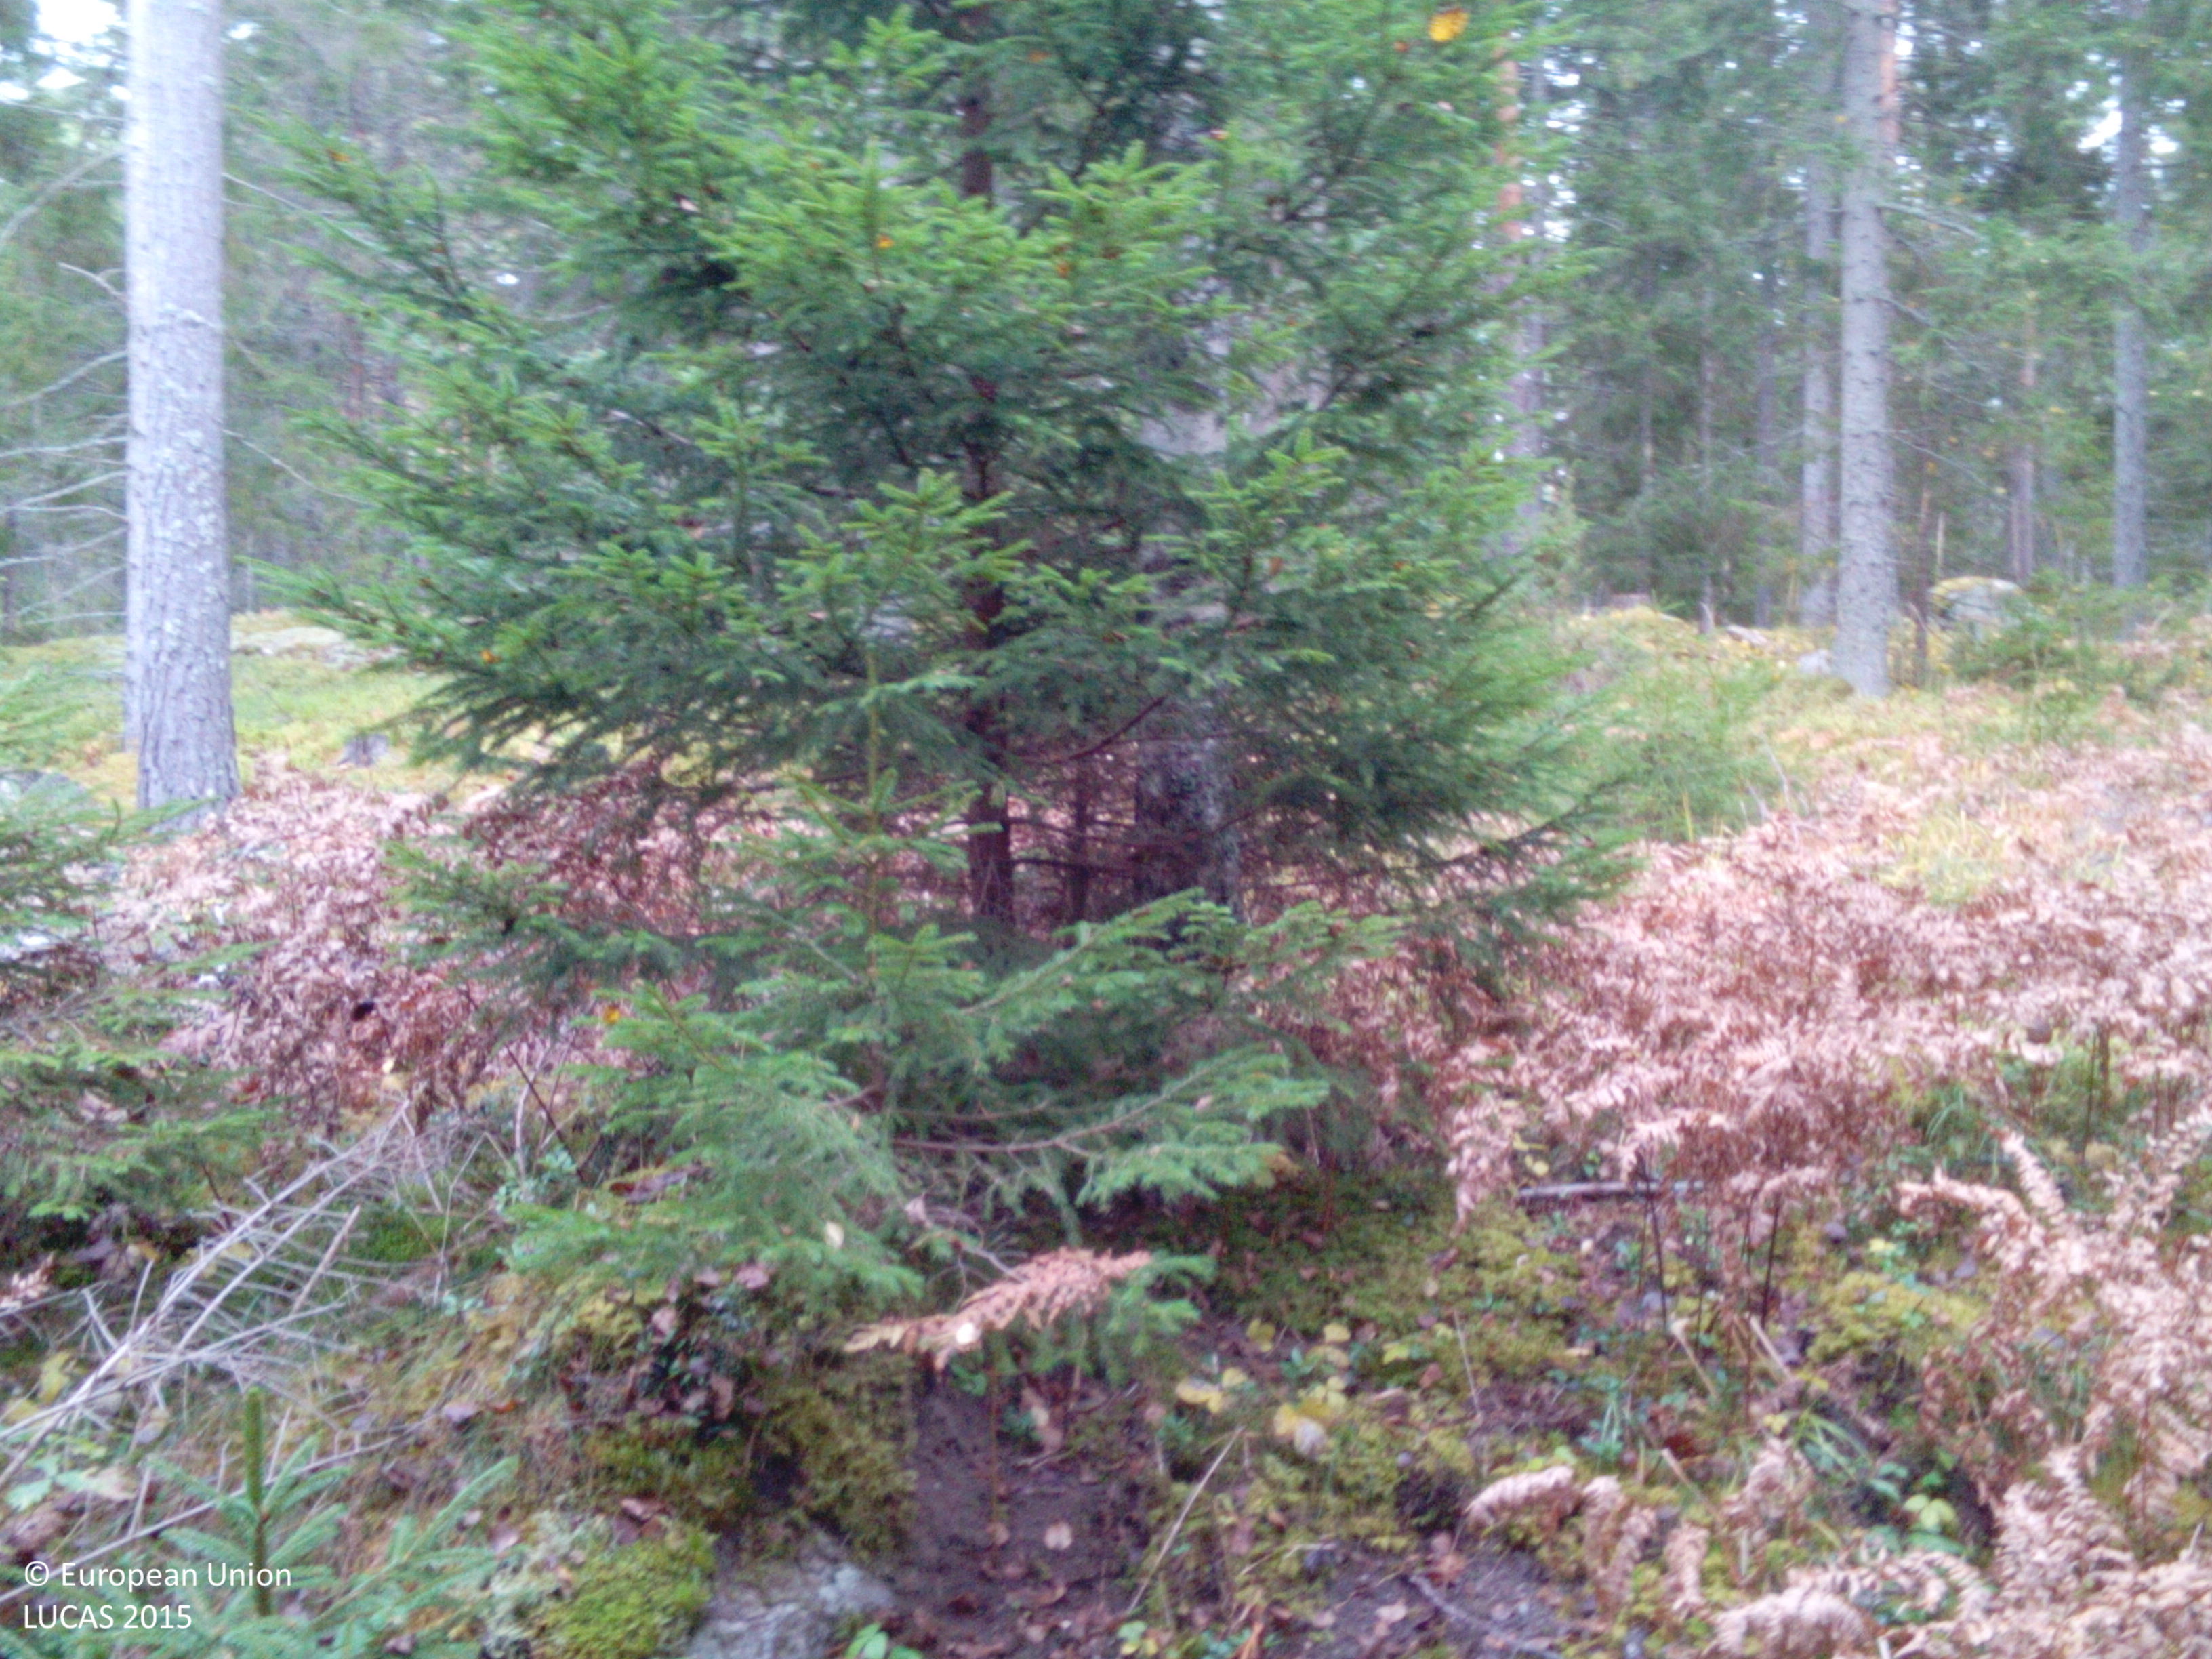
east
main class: Woodland
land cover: Spruce dominated coniferous woodland
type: boreal forest
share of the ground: 50 - 75 %
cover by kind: coniferous forest trees 75 %, lichens and mosses 15 %, herbaceous plants 10 %
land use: Forestry
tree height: > 5 m
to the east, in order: Spruce dominated coniferous woodland; Ditches and canals; Spruce dominated coniferous woodland; Other coniferous woodland; Pine dominated coniferous woodland
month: October
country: SE
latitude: 59.2442
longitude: 16.3221
